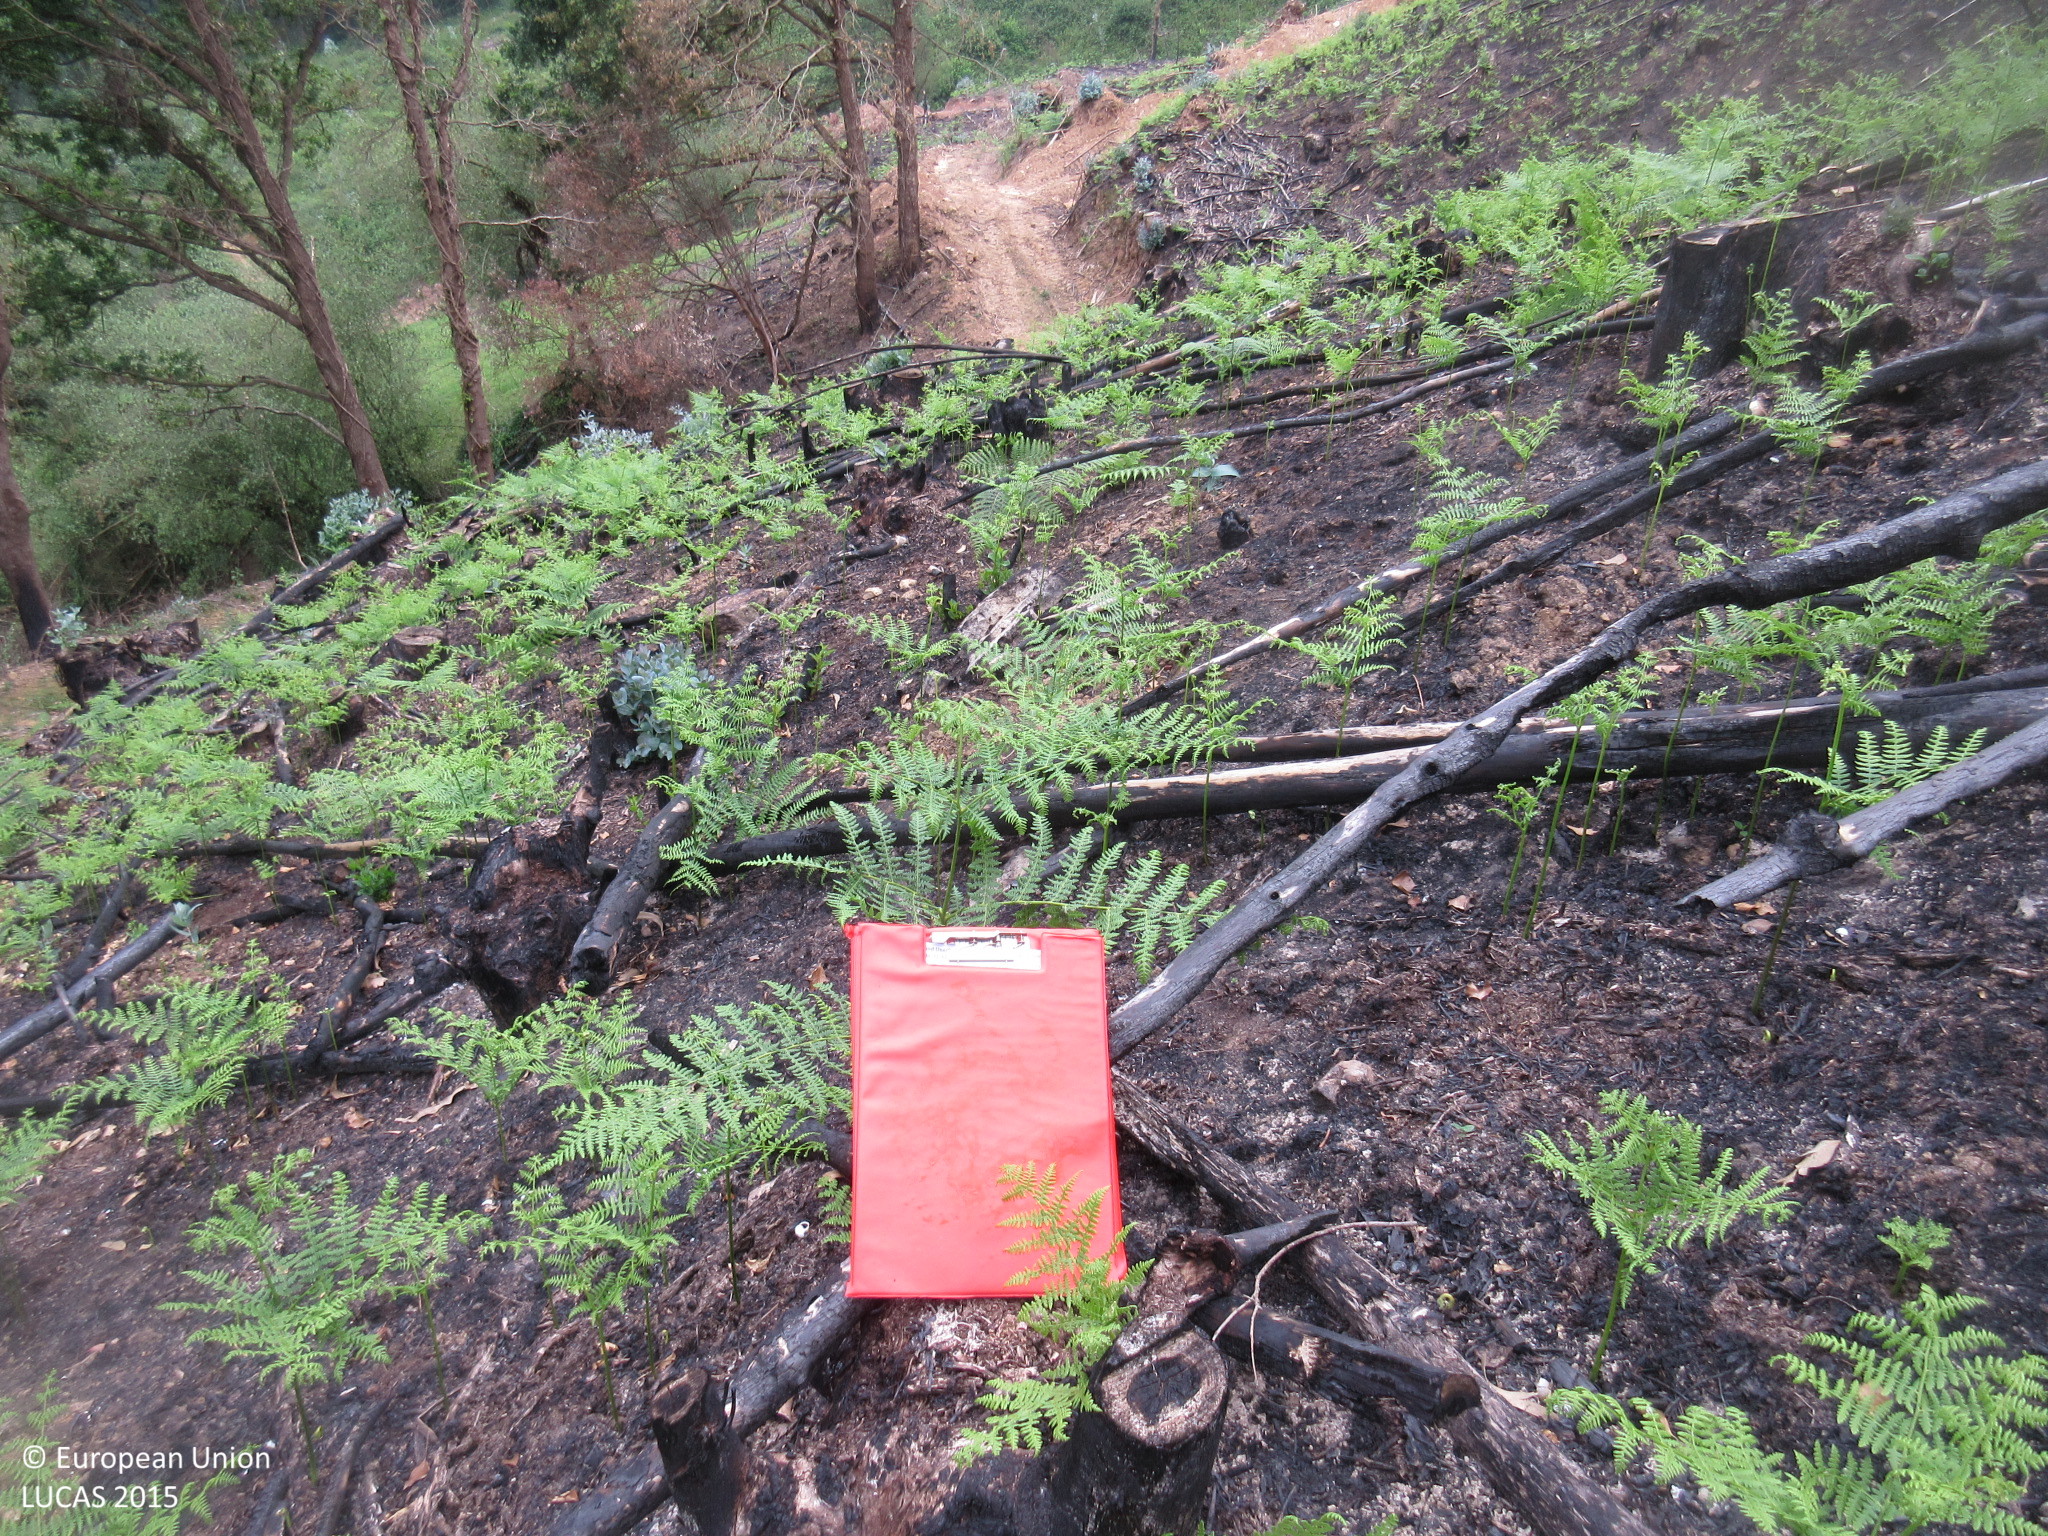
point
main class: Grassland
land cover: Grassland without tree/shrub cover
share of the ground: 25 - 50 %
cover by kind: unconsolidated bare surface 70 %, herbaceous plants 30 %
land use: Semi-natural and natural areas not in use
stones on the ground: < 10 %
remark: Burnt area
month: June
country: ES
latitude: 43.3246
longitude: -3.4469
